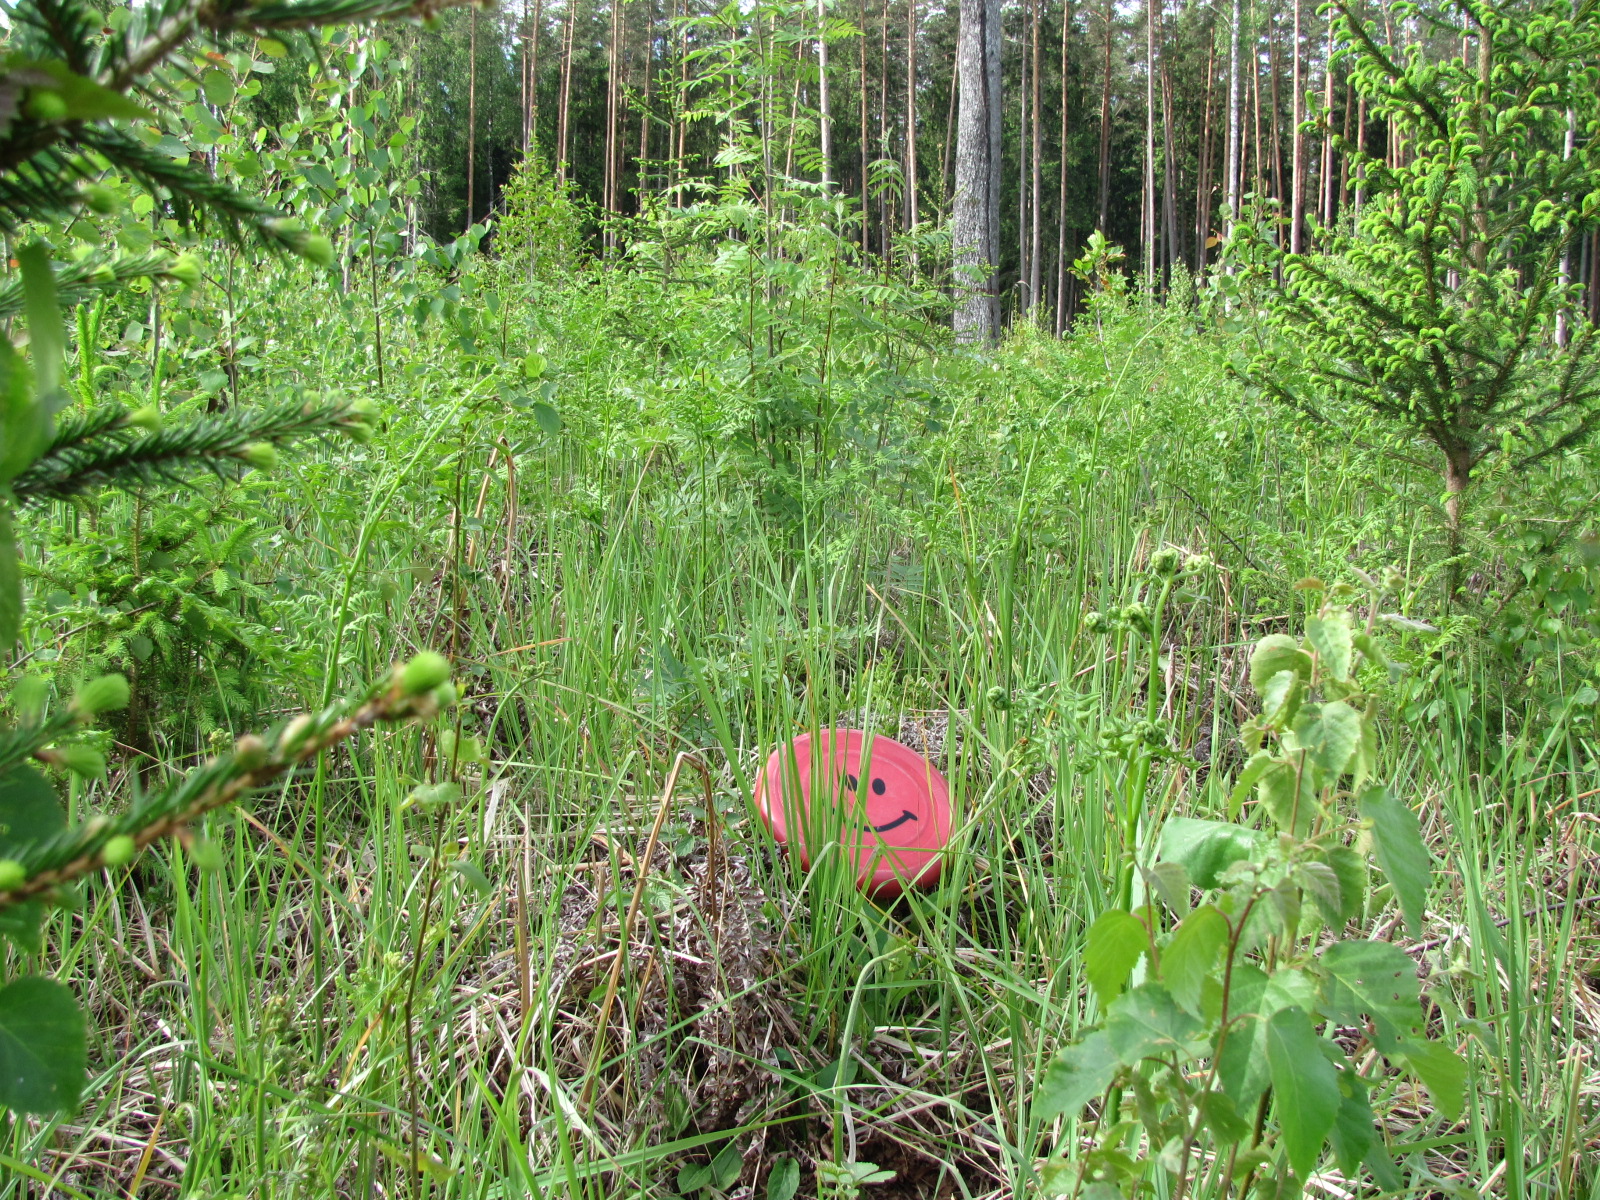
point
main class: Woodland
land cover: Spruce dominated mixed woodland
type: hemiboreal forest and nemoral coniferous forest and mixed broadleaved-coniferous forest
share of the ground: 50 - 75 %
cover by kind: broadleaved forest trees 40 %, coniferous forest trees 30 %, herbaceous plants 30 %
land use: Forestry
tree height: < 5 m
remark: Nursery
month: June
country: LV
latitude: 56.7005
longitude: 23.9487
